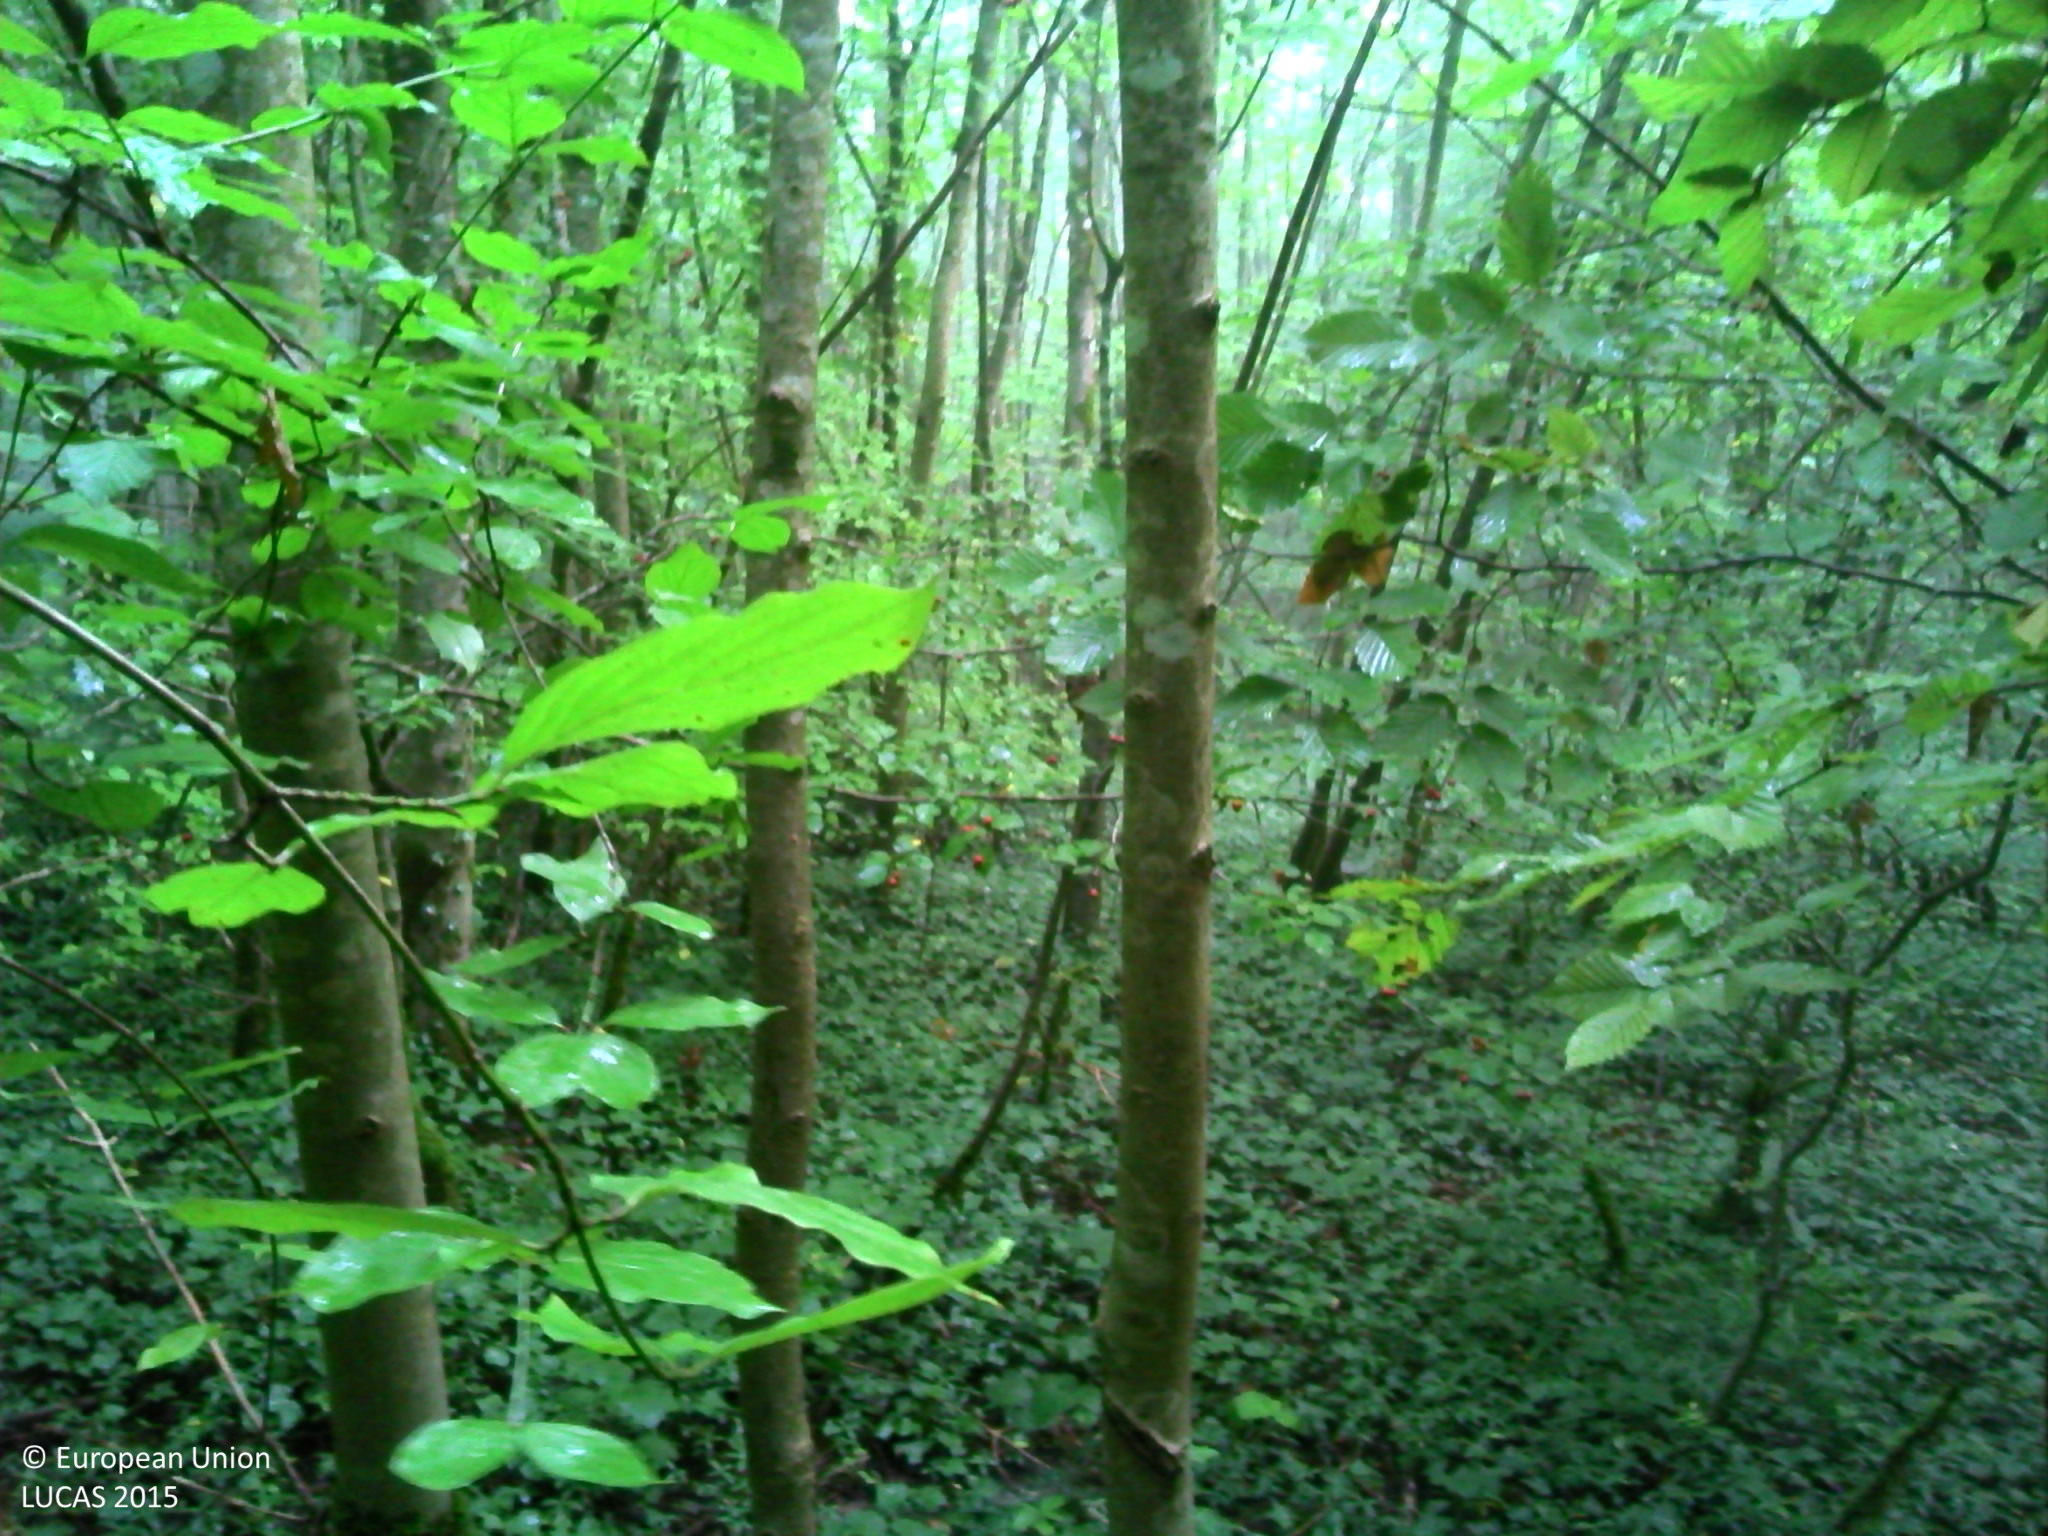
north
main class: Woodland
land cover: Broadleaved woodland
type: mesophytic deciduous forest
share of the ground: > 75 %
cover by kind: broadleaved forest trees 90 %, herbaceous plants 5 %, consolidated bare surface 5 %
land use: Forestry
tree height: > 5 m
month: September
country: FR
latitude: 49.2508
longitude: 6.0291
